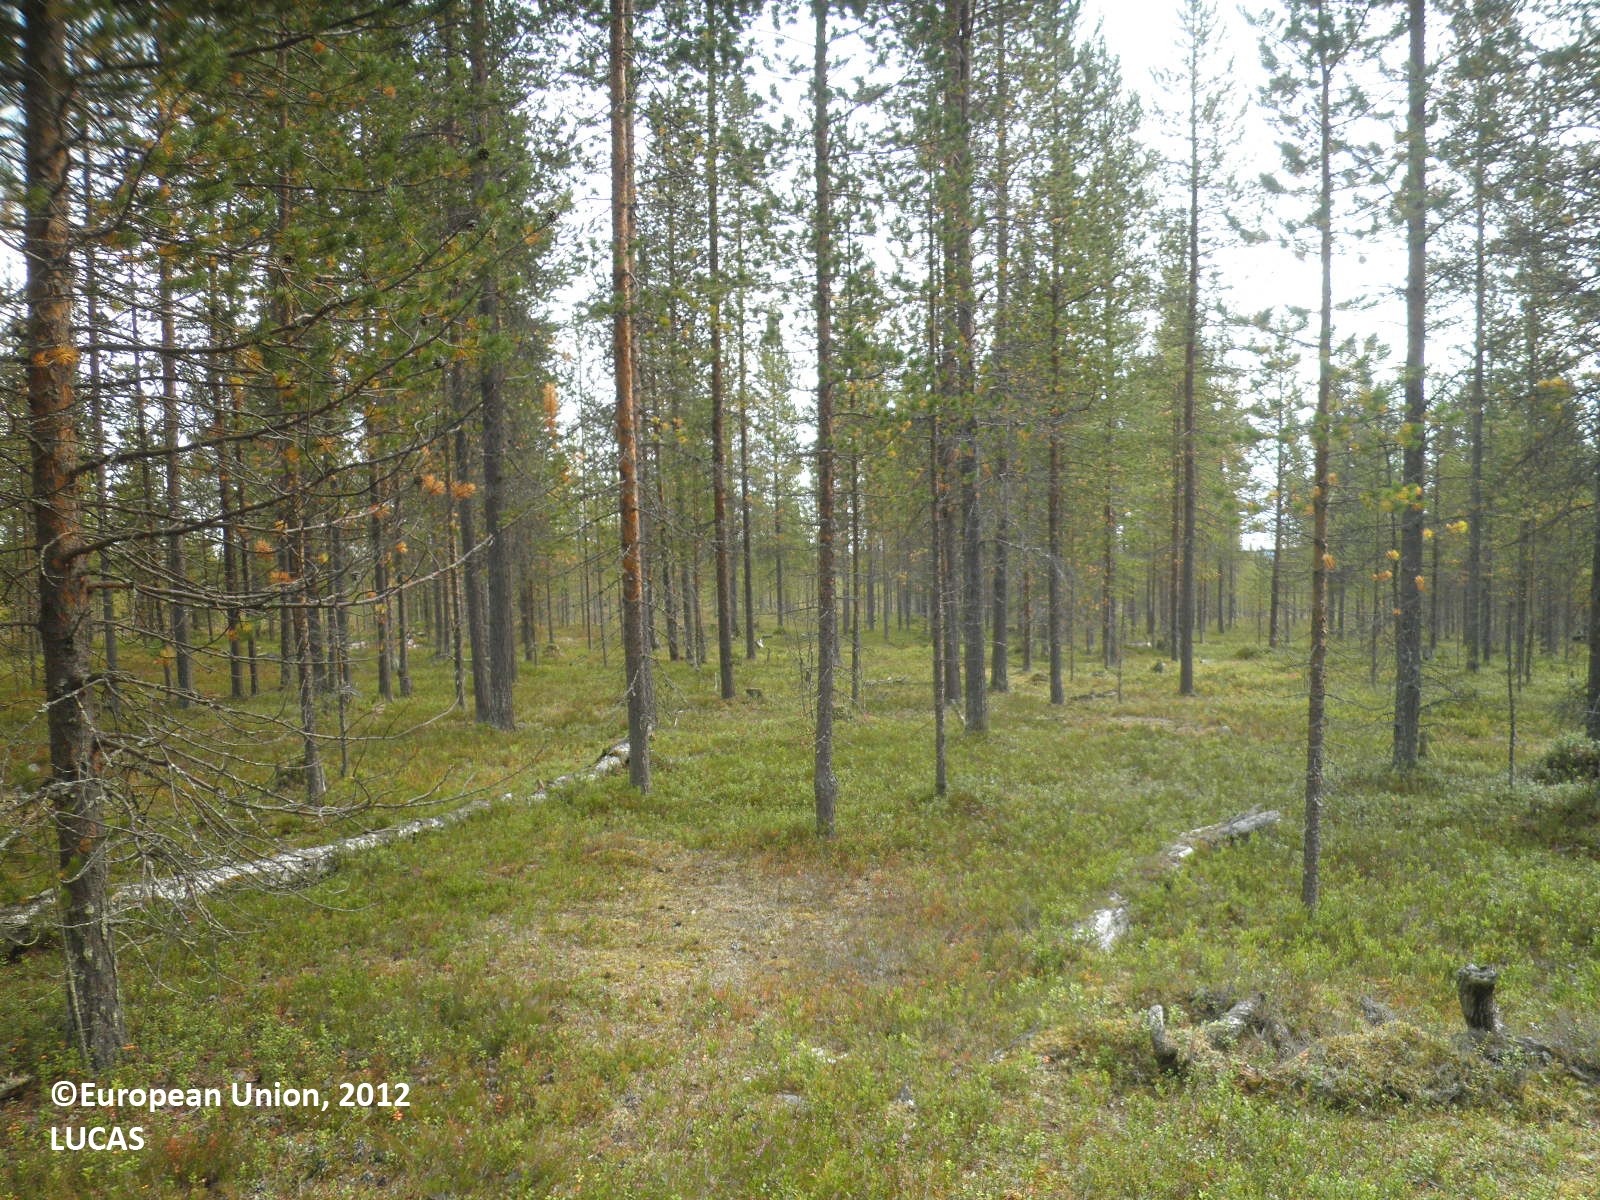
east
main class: Woodland
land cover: Pine dominated coniferous woodland
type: boreal forest
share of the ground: 50 - 75 %
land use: Forestry
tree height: > 5 m
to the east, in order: Pine dominated coniferous woodland
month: August
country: FI
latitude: 67.7451
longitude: 28.9006
